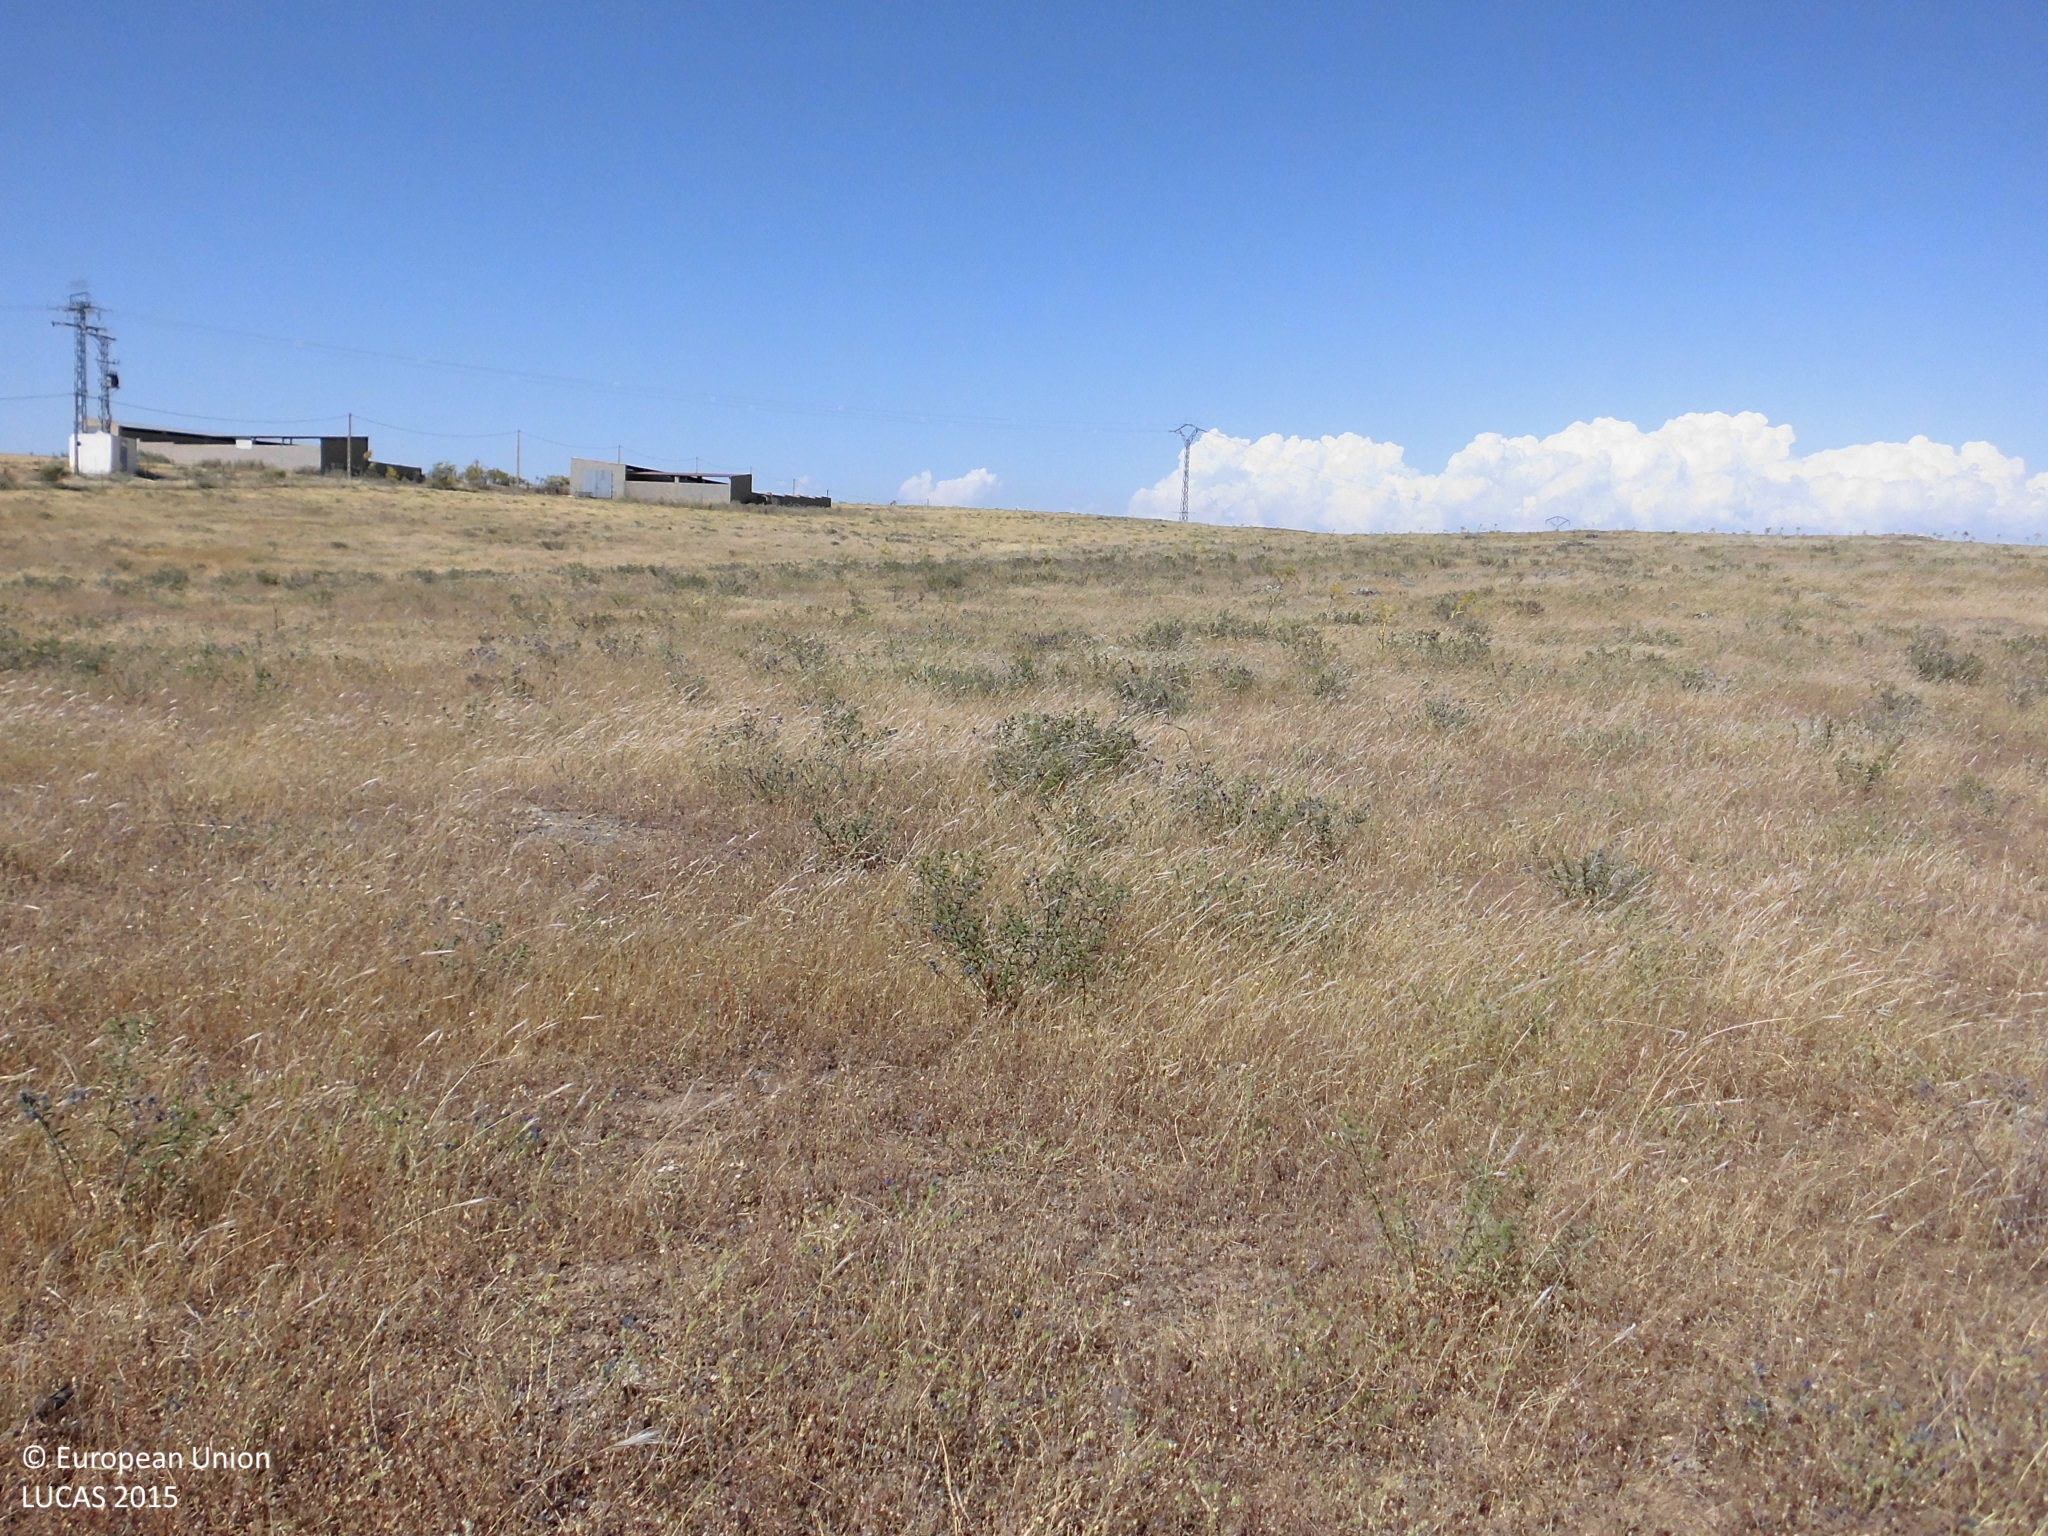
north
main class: Grassland
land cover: Grassland without tree/shrub cover
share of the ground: > 75 %
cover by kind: herbaceous plants 100 %
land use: Agriculture (excluding fallow land and kitchen gardens)
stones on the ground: 10 - 25 %
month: May
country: ES
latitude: 39.3750
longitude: -6.0680
